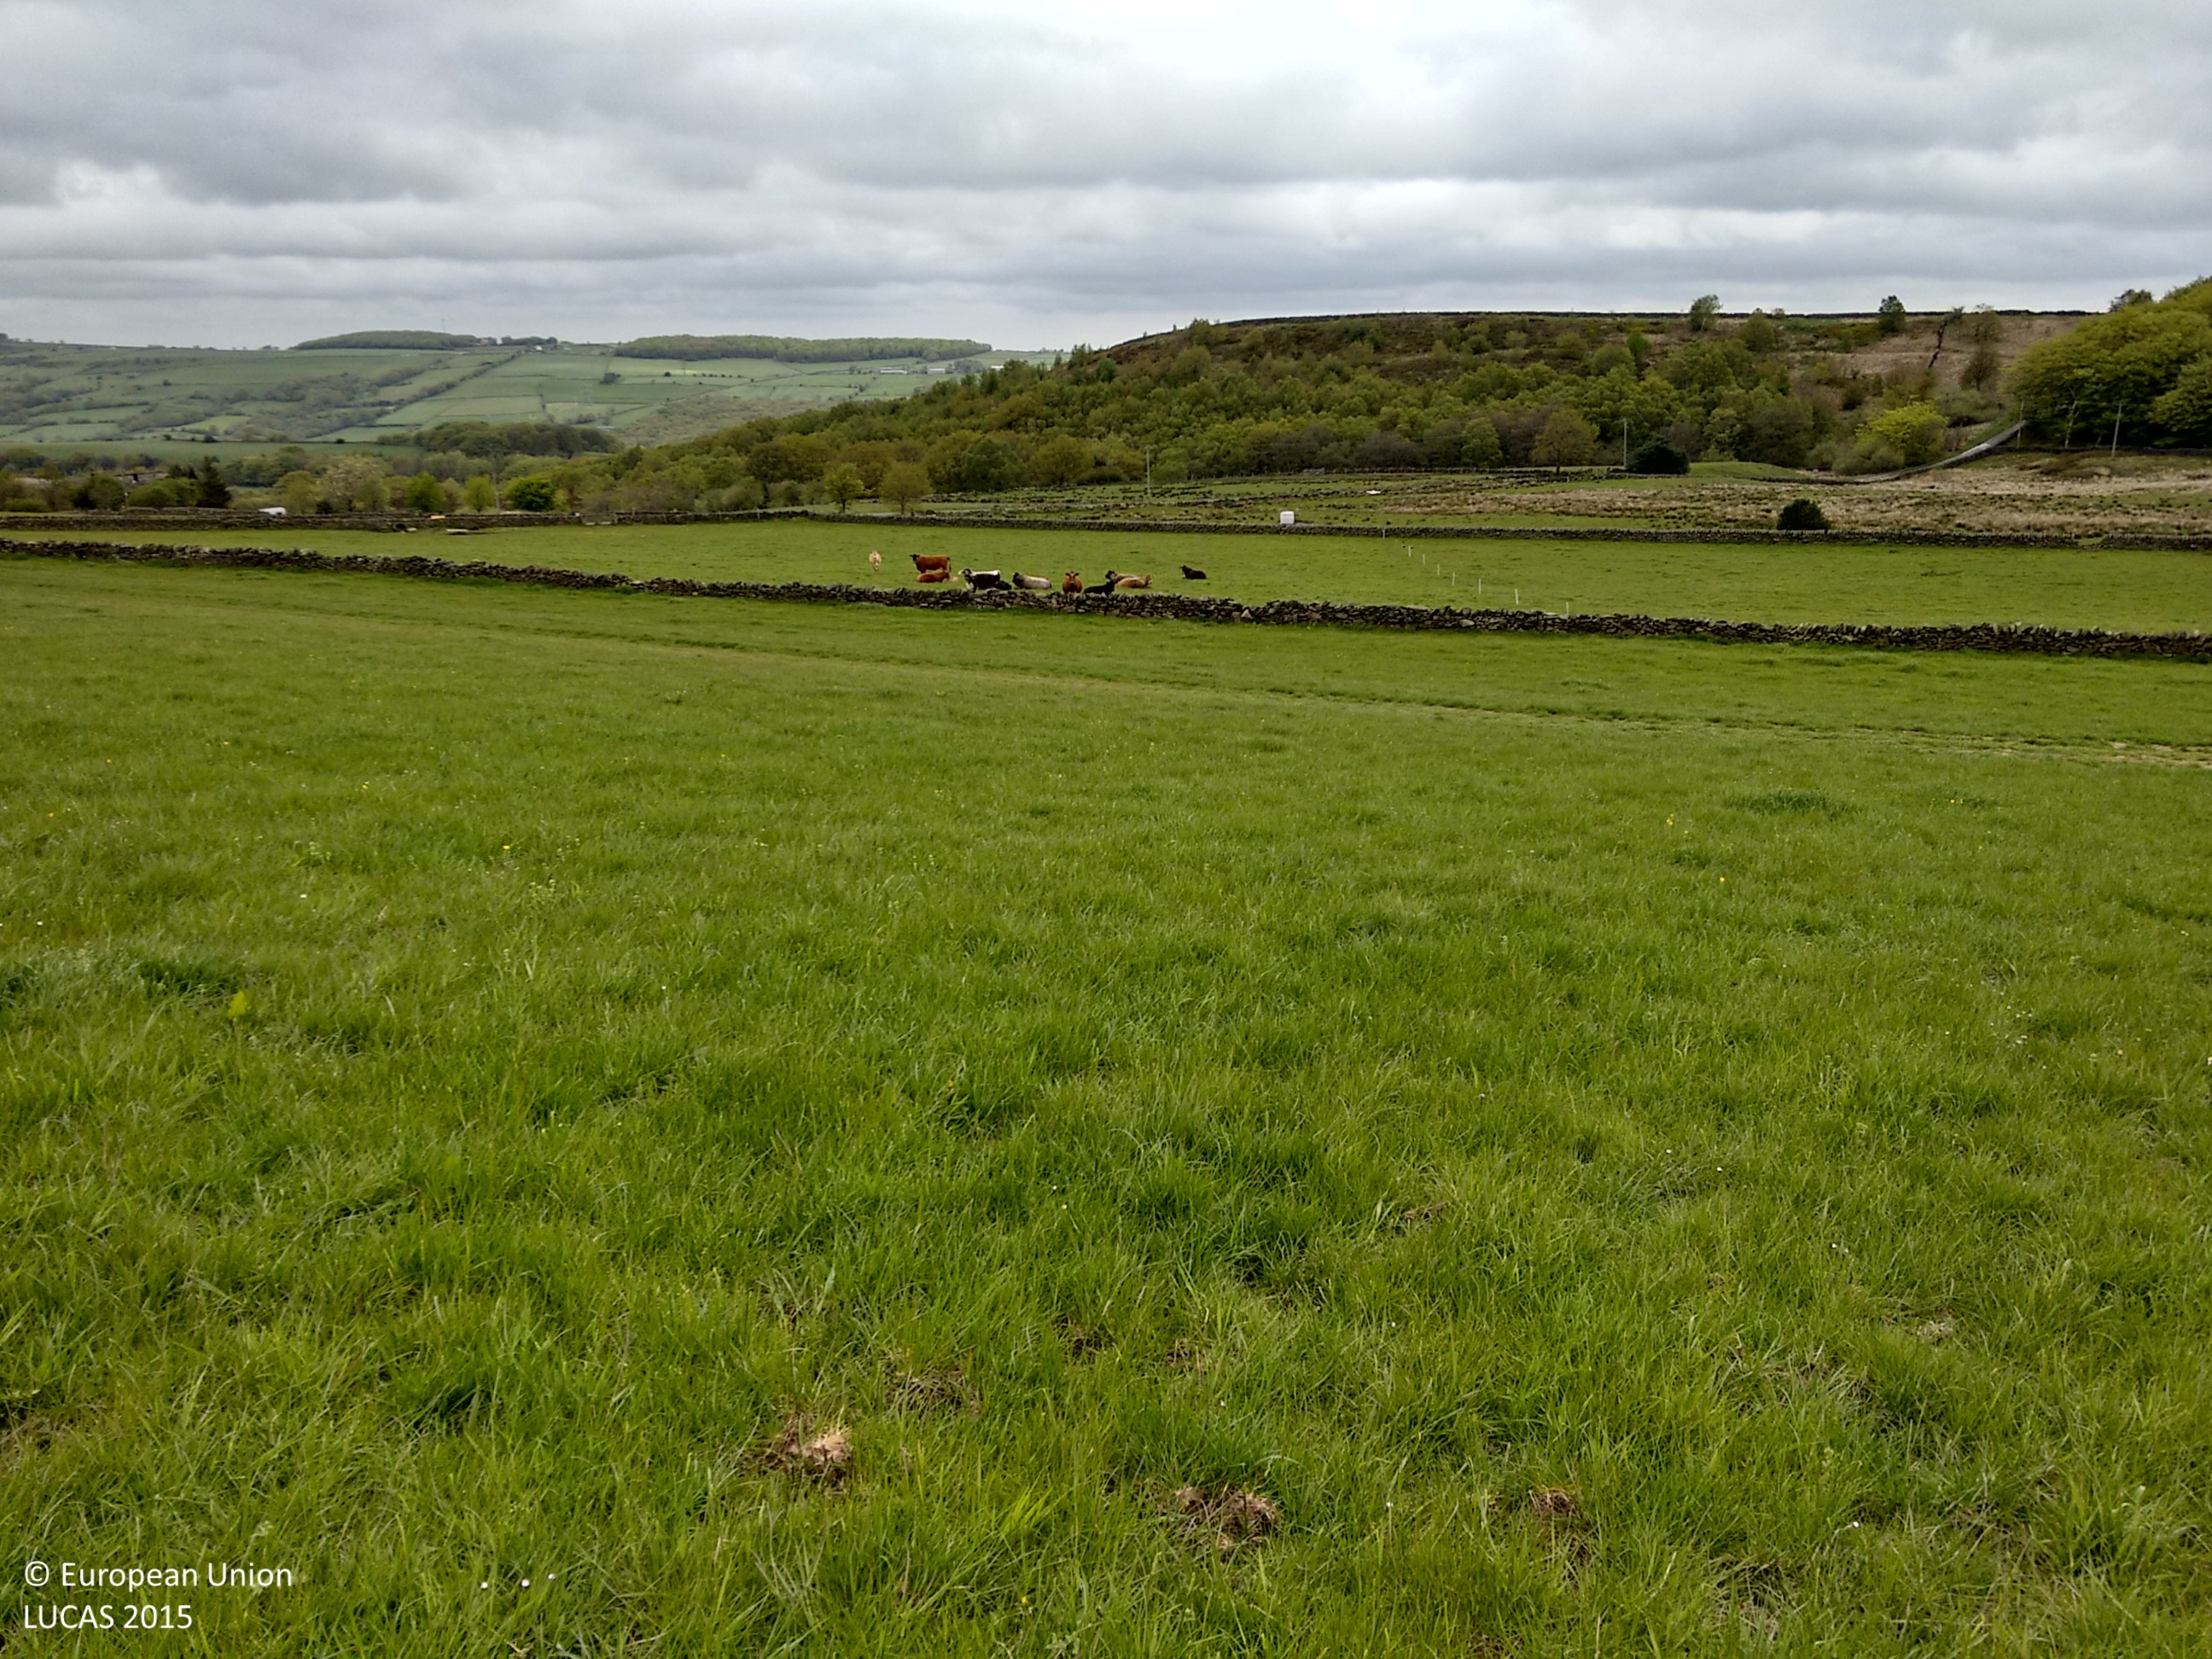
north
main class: Grassland
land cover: Grassland without tree/shrub cover
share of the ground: > 75 %
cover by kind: herbaceous plants 100 %
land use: Agriculture (excluding fallow land and kitchen gardens)
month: May
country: GB
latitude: 53.4746
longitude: -1.6382
